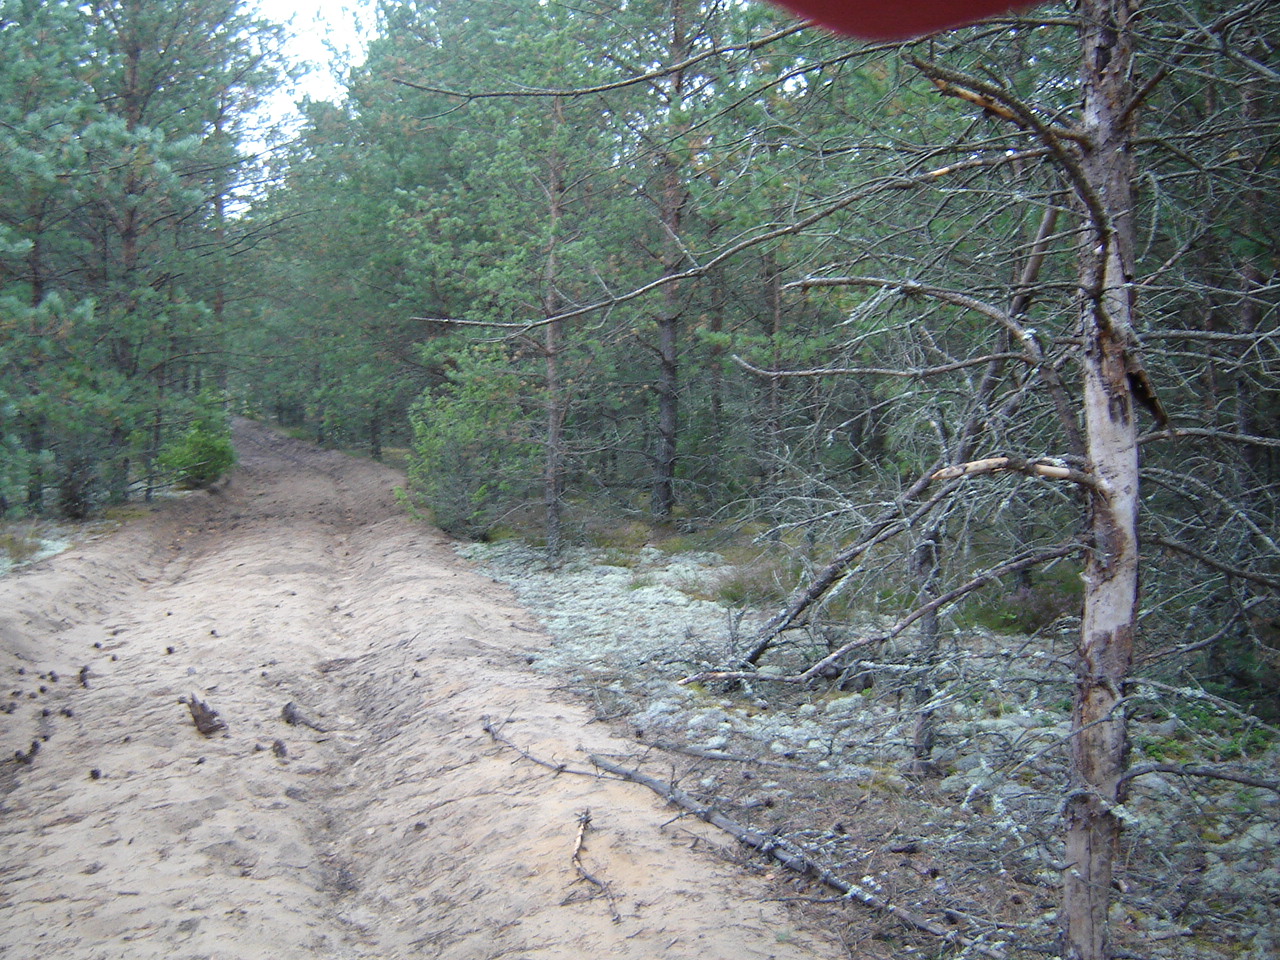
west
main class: Woodland
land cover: Pine dominated coniferous woodland
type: hemiboreal forest and nemoral coniferous forest and mixed broadleaved-coniferous forest
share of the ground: > 75 %
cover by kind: coniferous forest trees 85 %, lichens and mosses 15 %
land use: Forestry
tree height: > 5 m
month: September
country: LT
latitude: 54.3305
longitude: 24.8275
